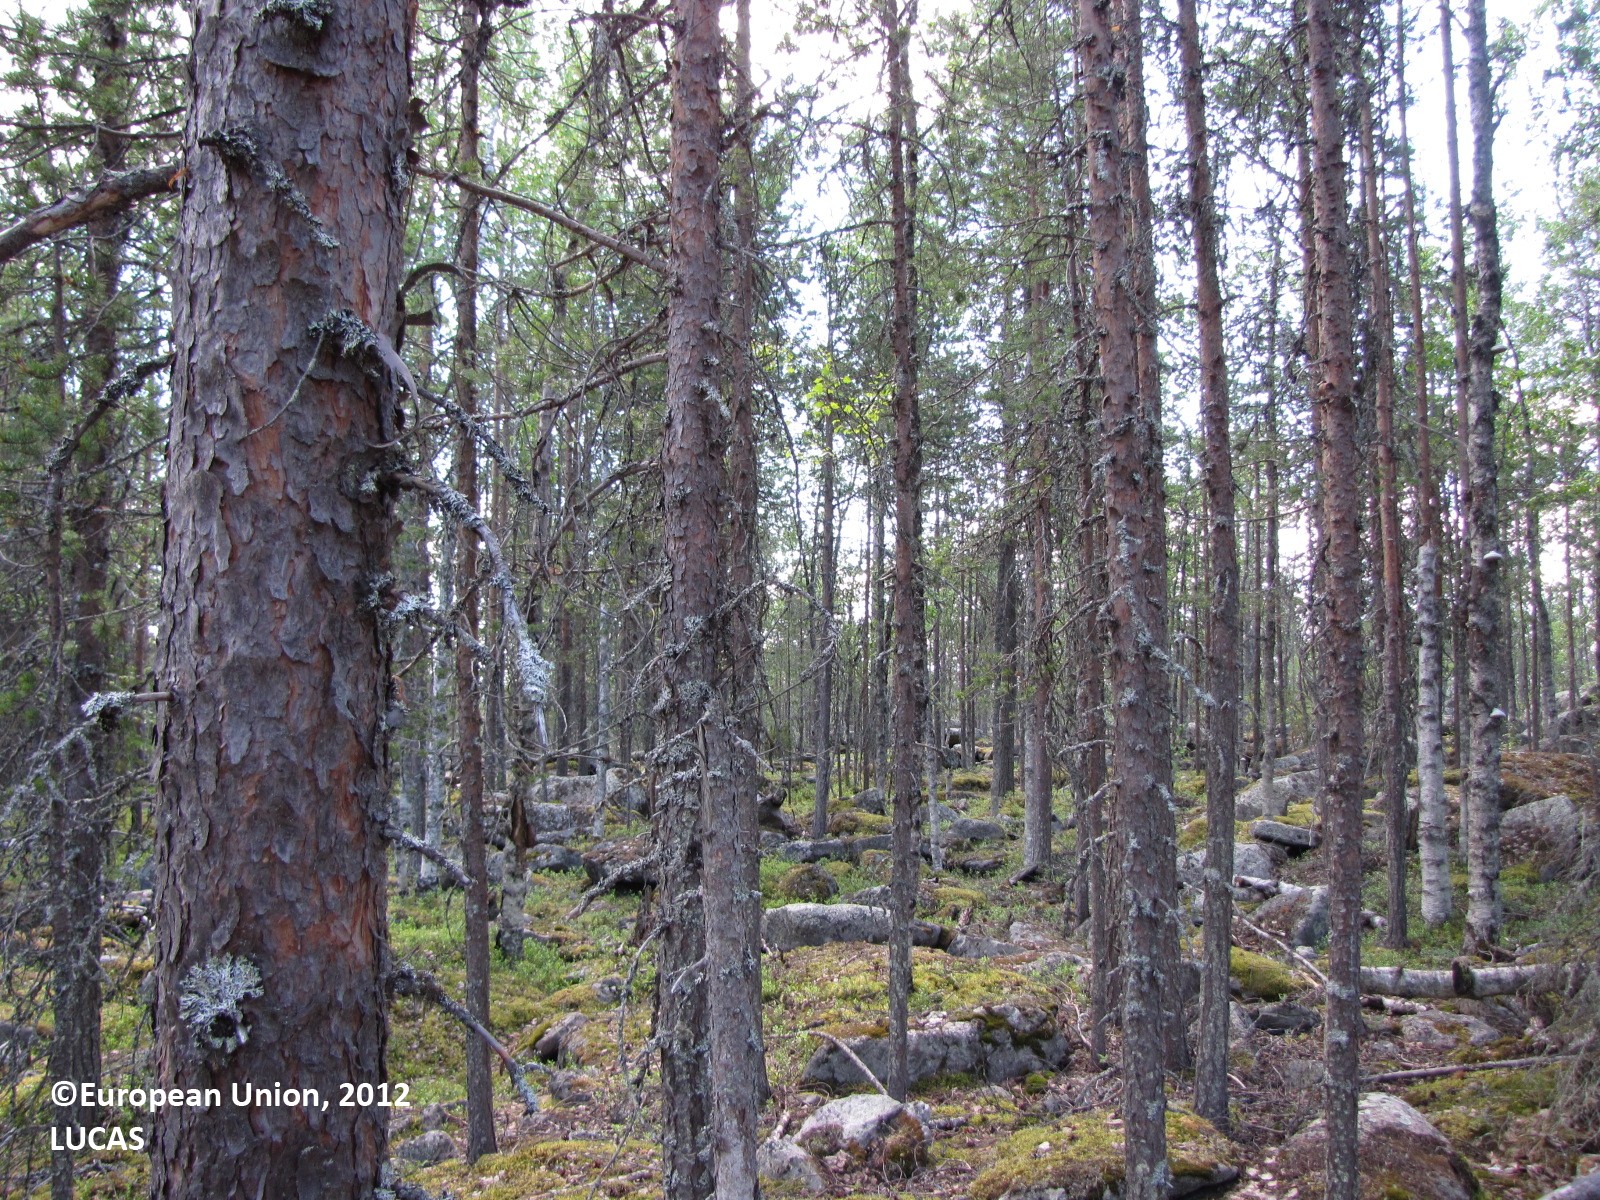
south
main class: Woodland
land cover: Pine dominated mixed woodland
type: boreal forest
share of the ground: 50 - 75 %
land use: Forestry
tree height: > 5 m
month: July
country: FI
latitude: 66.5139
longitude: 24.5033
